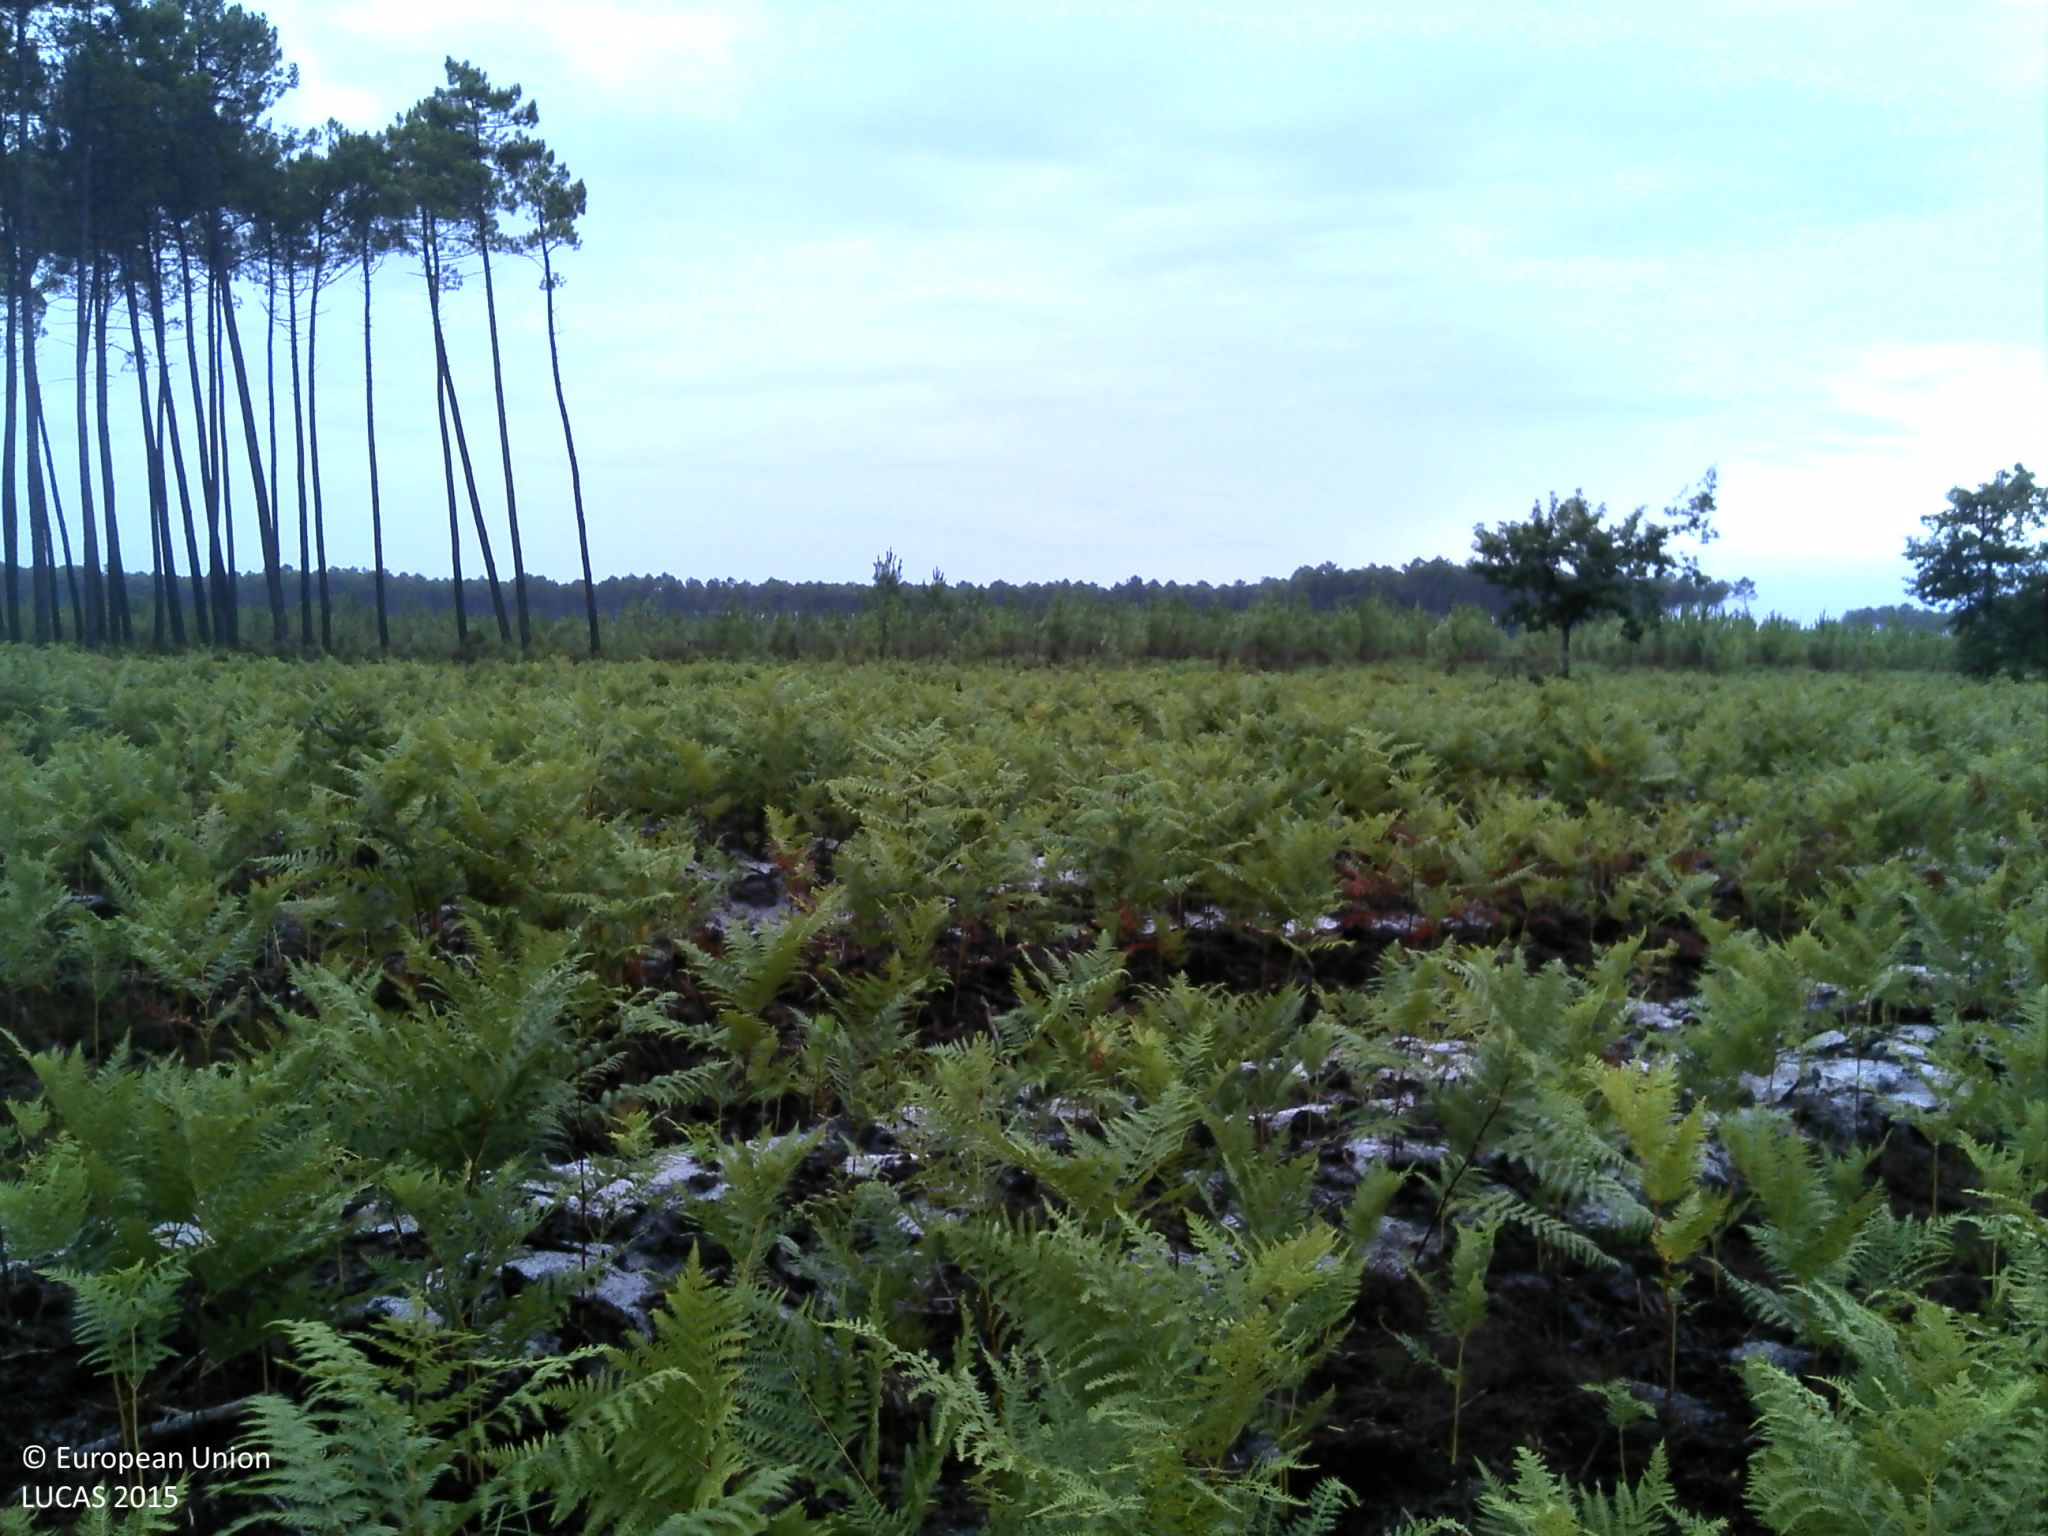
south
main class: Grassland
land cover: Spontaneously vegetated surfaces
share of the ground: > 75 %
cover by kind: herbaceous plants 90 %, shrubs 5 %, lichens and mosses 5 %
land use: Forestry
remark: Clear cut
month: August
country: FR
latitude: 44.5378
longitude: -0.9060
